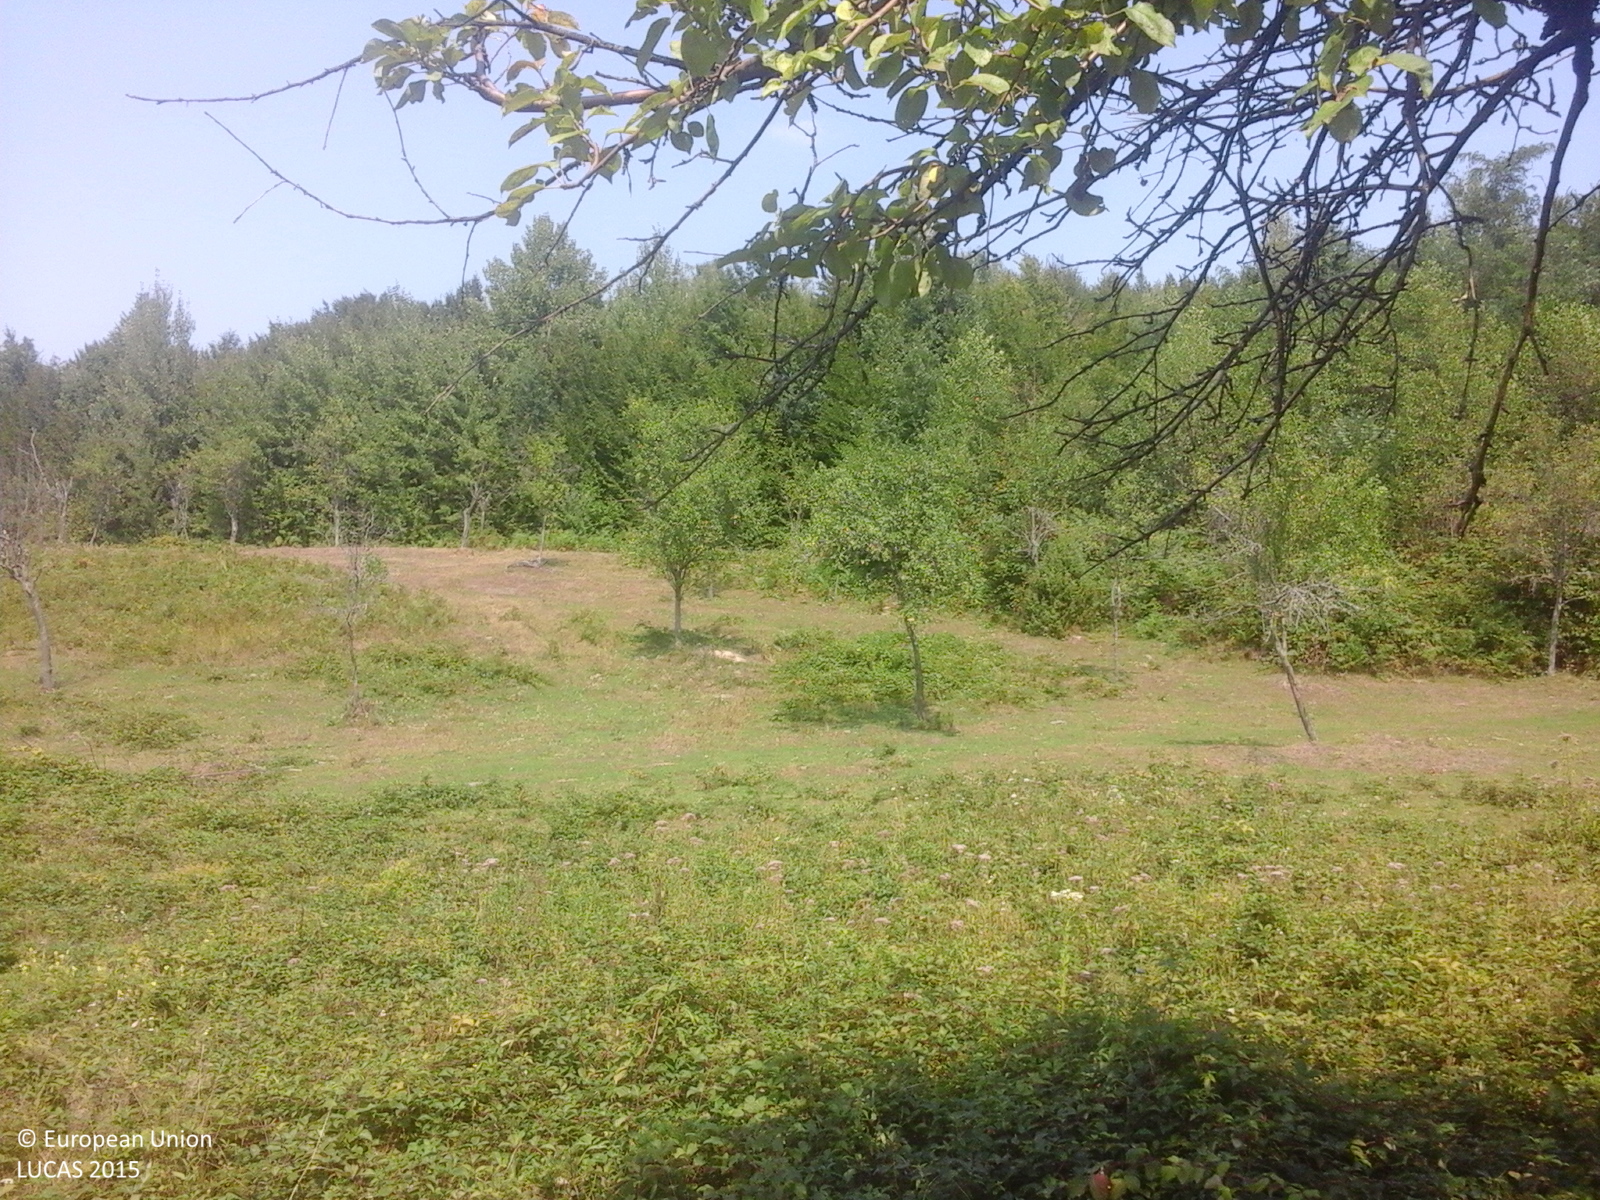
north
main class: Cropland
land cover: Apple fruit
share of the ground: > 75 %
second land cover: Grassland without tree/shrub cover
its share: > 75 %
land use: Agriculture (excluding fallow land and kitchen gardens)
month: August
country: RO
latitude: 46.3182
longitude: 22.5578
